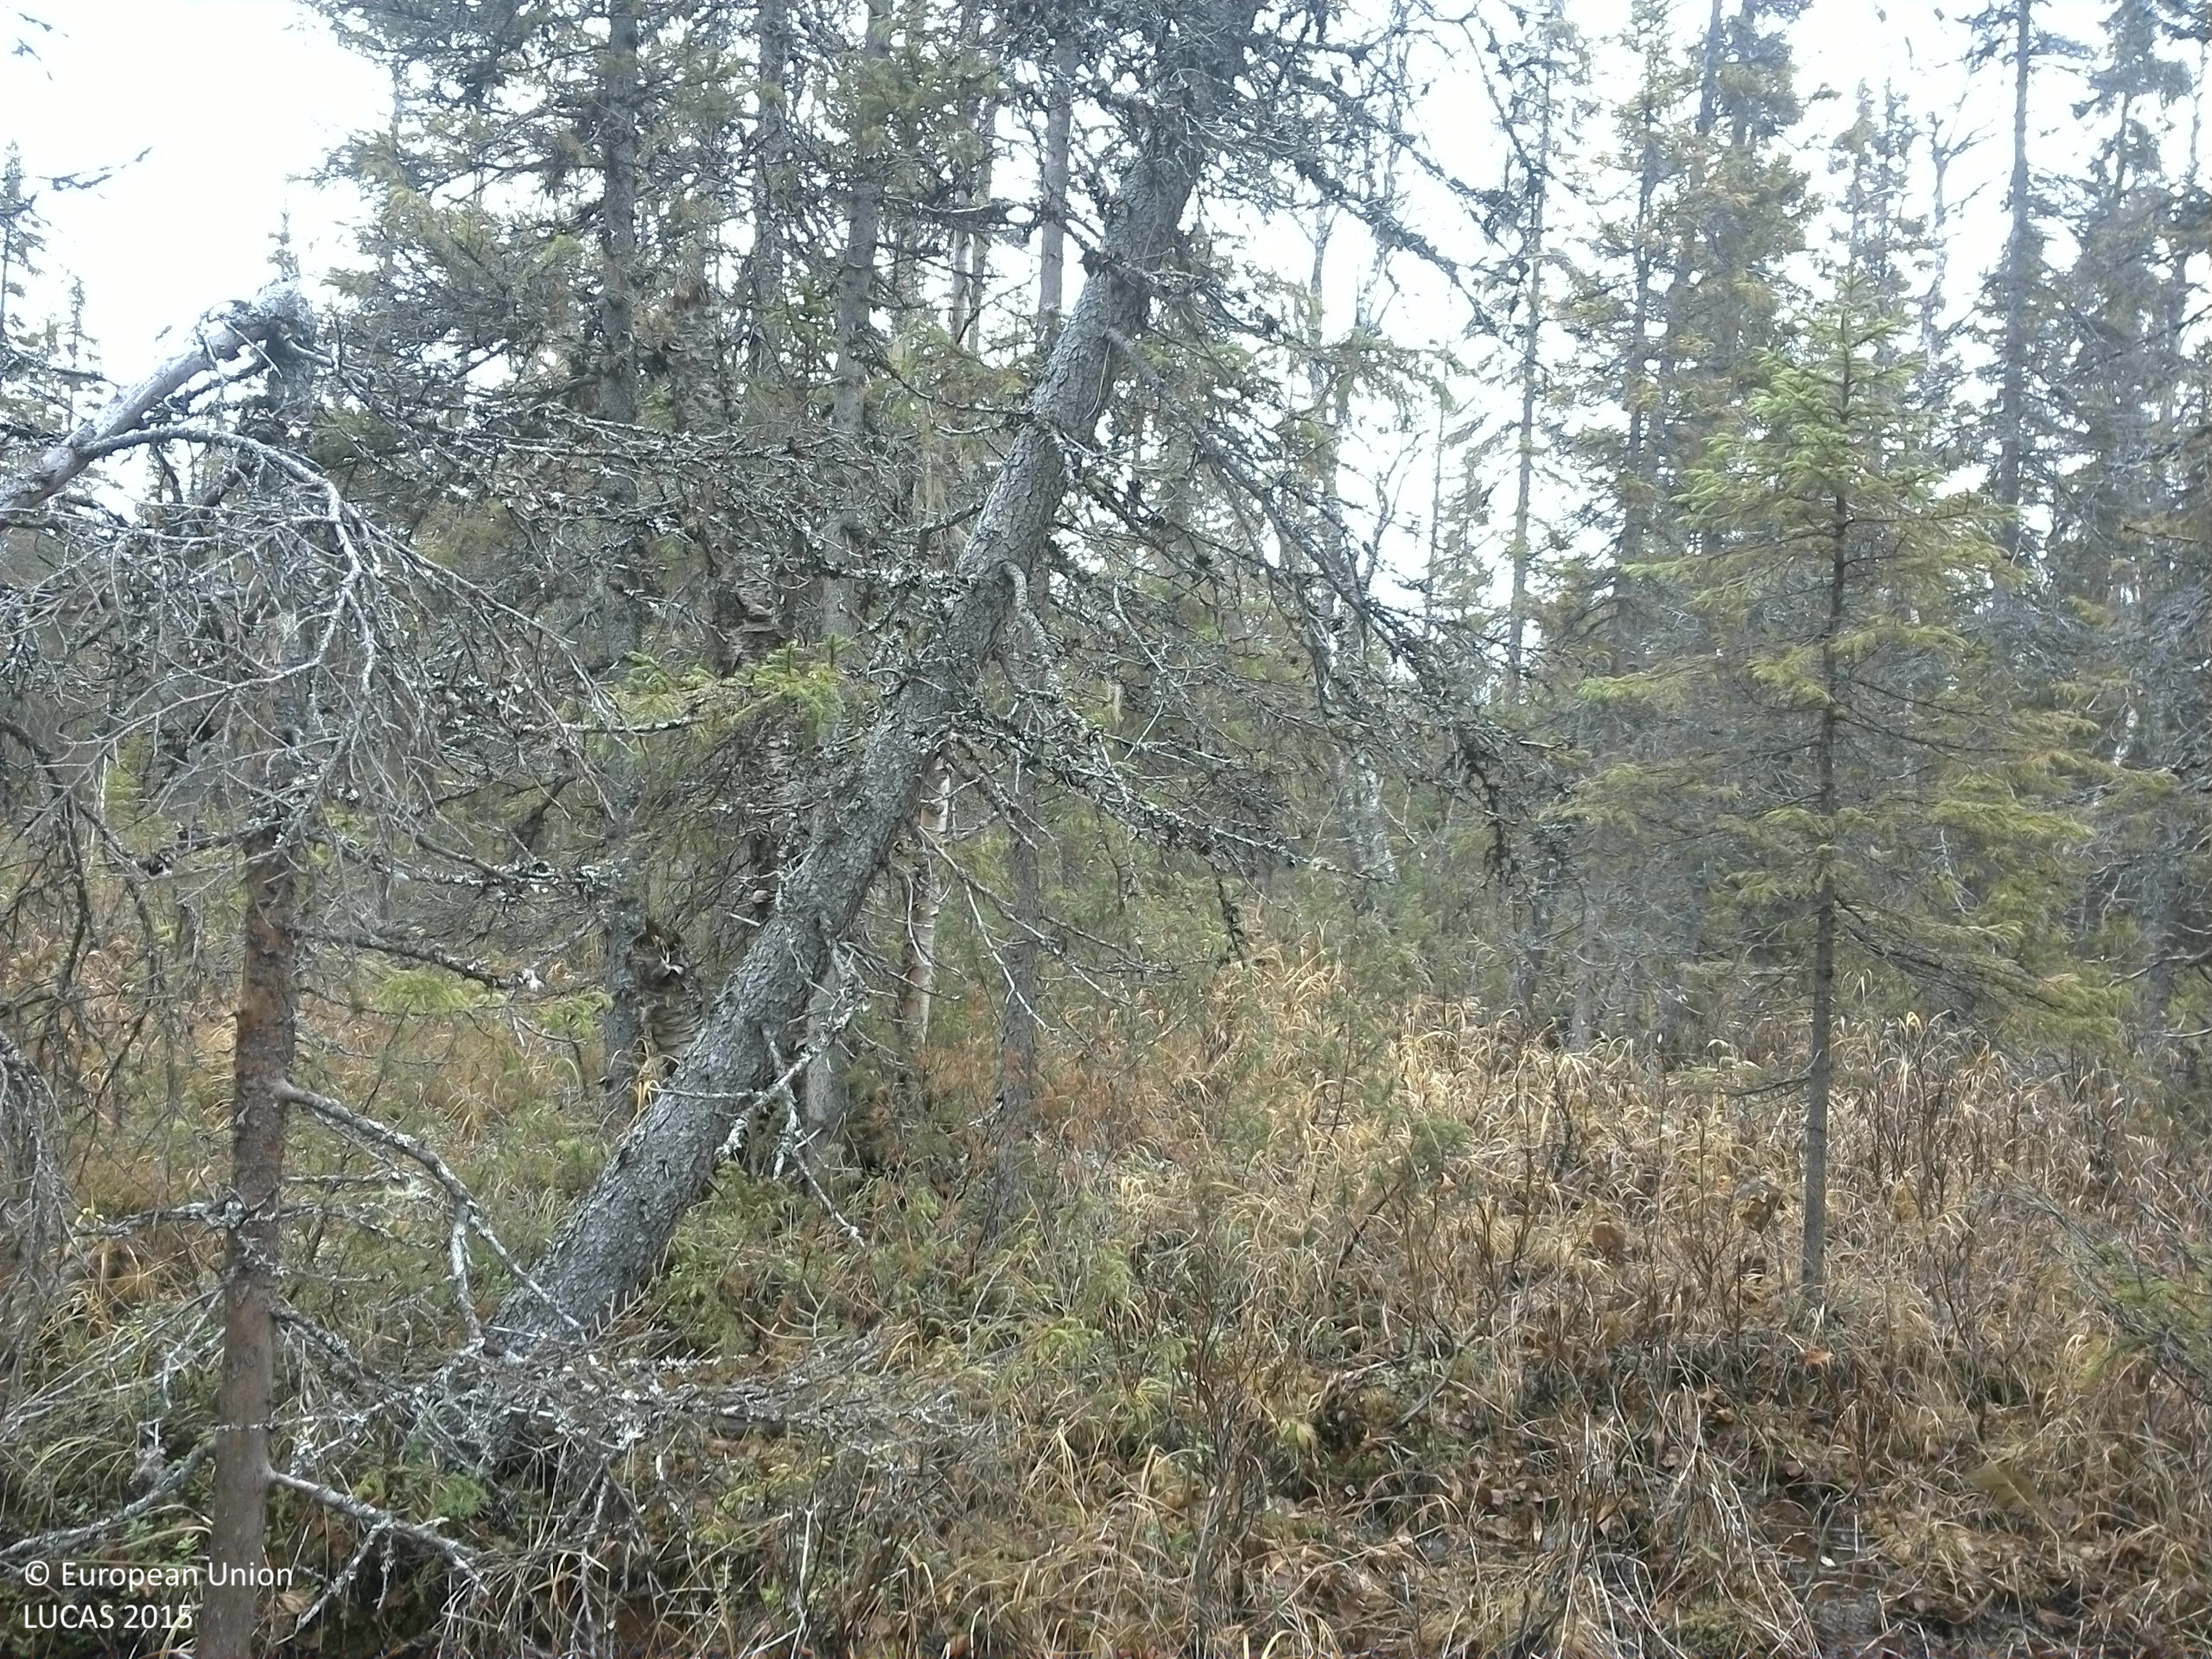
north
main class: Woodland
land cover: Spruce dominated mixed woodland
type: boreal forest
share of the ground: 50 - 75 %
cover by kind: coniferous forest trees 40 %, shrubs 25 %, broadleaved forest trees 15 %, lichens and mosses 15 %
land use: Forestry
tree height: > 5 m
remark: Temporary flooded
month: October
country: SE
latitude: 64.3433
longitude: 15.3740
